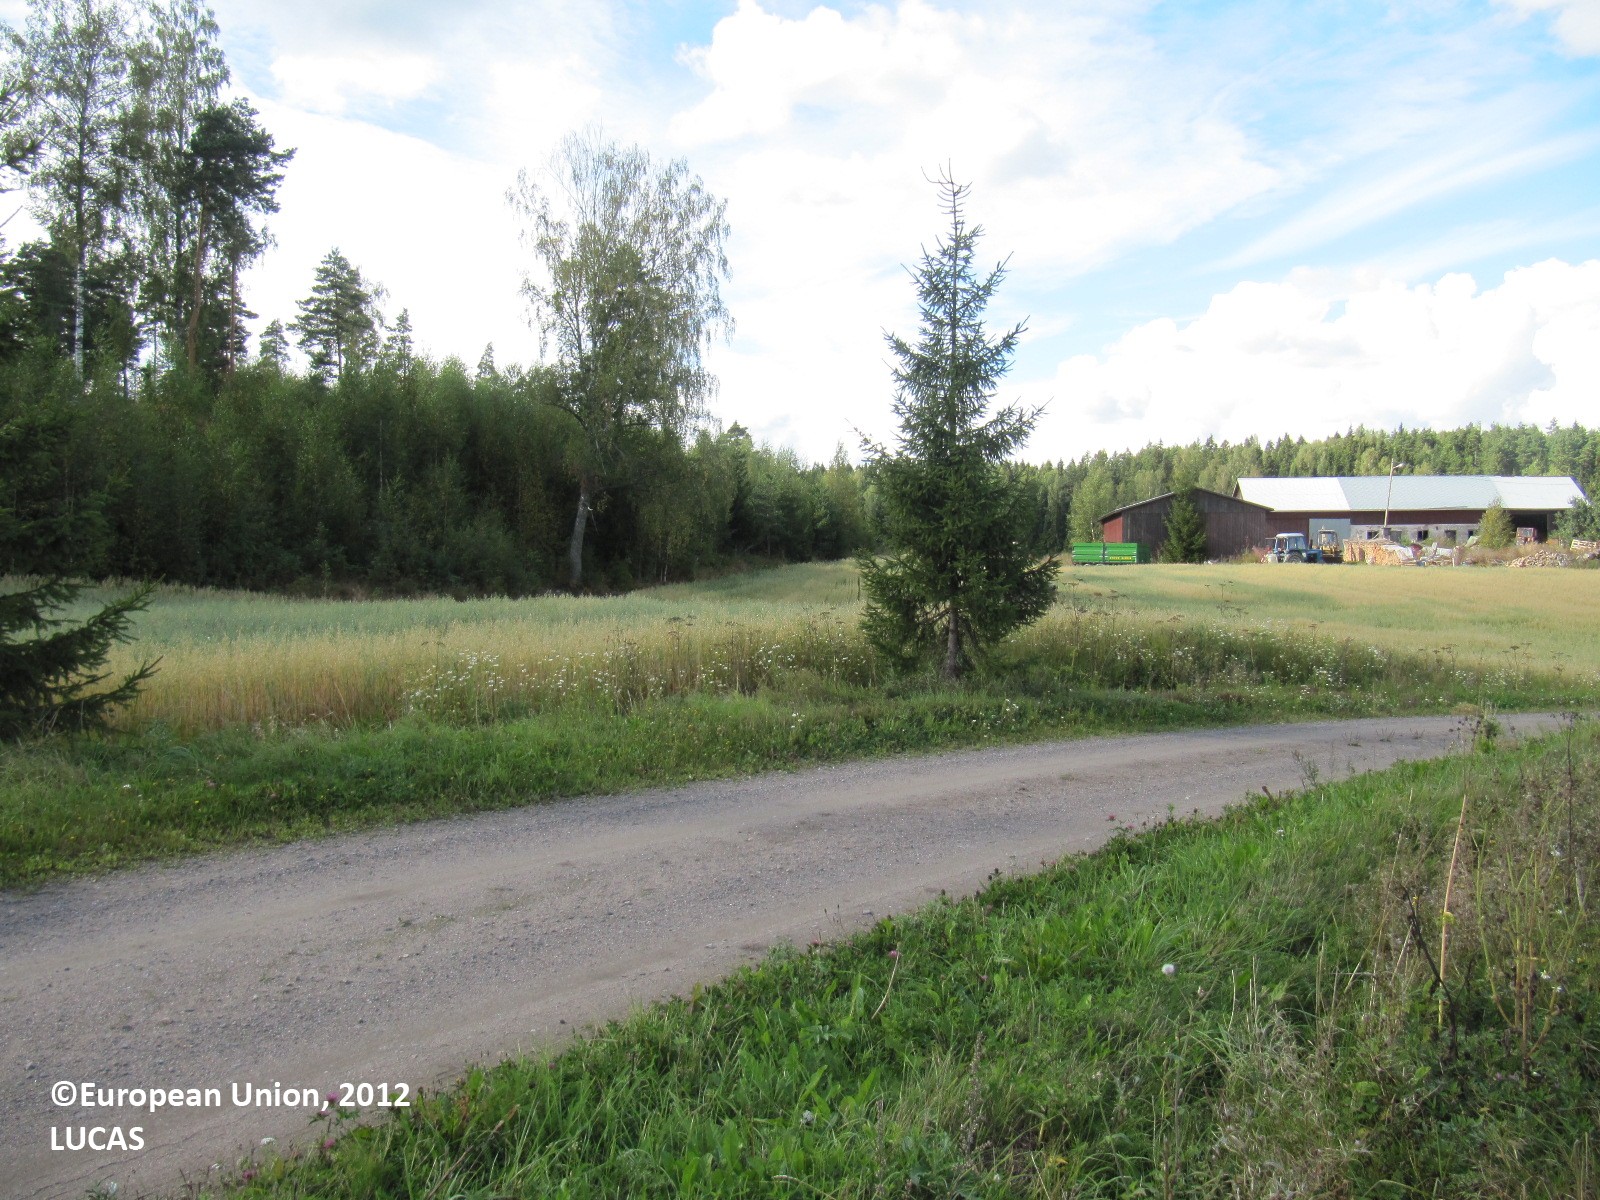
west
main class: Cropland
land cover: Oats
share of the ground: > 75 %
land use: Agriculture (excluding fallow land and kitchen gardens)
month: August
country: FI
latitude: 60.1603
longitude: 23.7692
